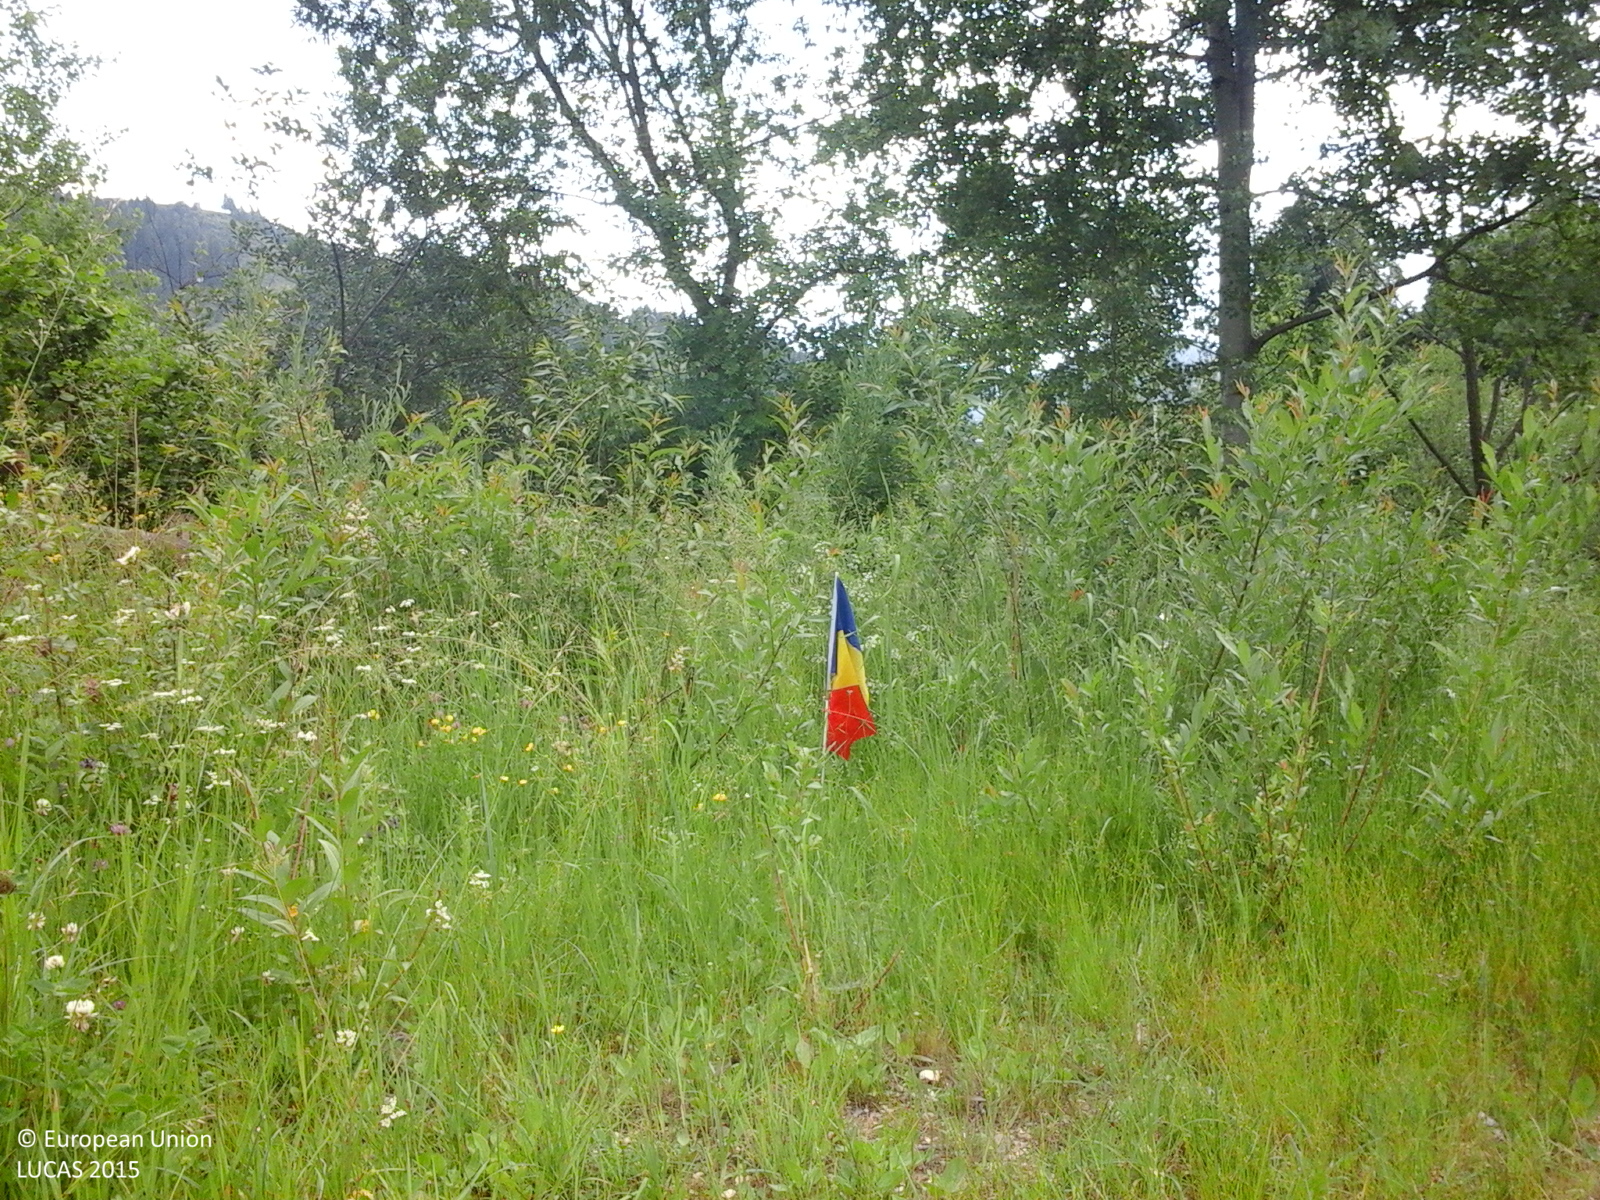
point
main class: Grassland
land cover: Grassland with sparse tree/shrub cover
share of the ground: > 75 %
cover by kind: herbaceous plants 95 %, broadleaved forest trees 5 %
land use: Agriculture (excluding fallow land and kitchen gardens)
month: June
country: RO
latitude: 47.5391
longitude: 25.3779
